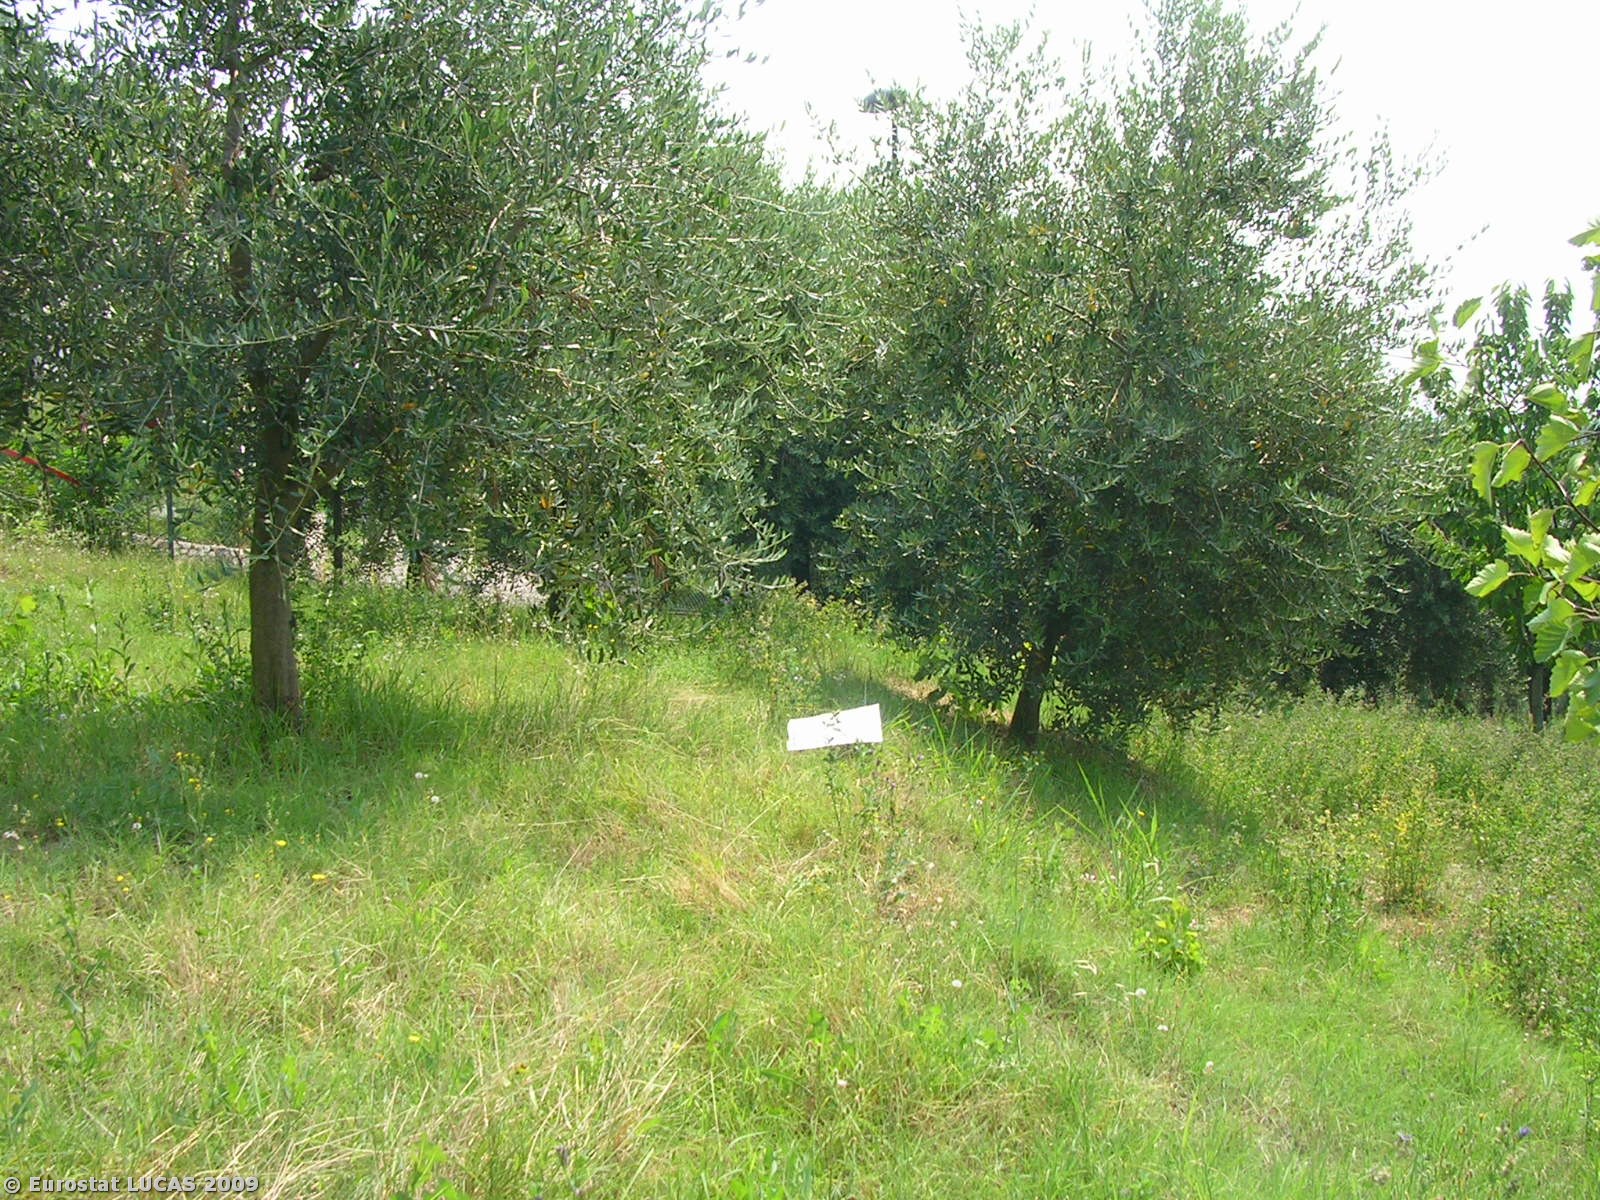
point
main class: Cropland
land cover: Olive groves
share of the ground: 50 - 75 %
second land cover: Grassland with sparse tree/shrub cover
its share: 50 - 75 %
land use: Agriculture (excluding fallow land and kitchen gardens)
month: July
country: IT
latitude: 45.2389
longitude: 11.6659
